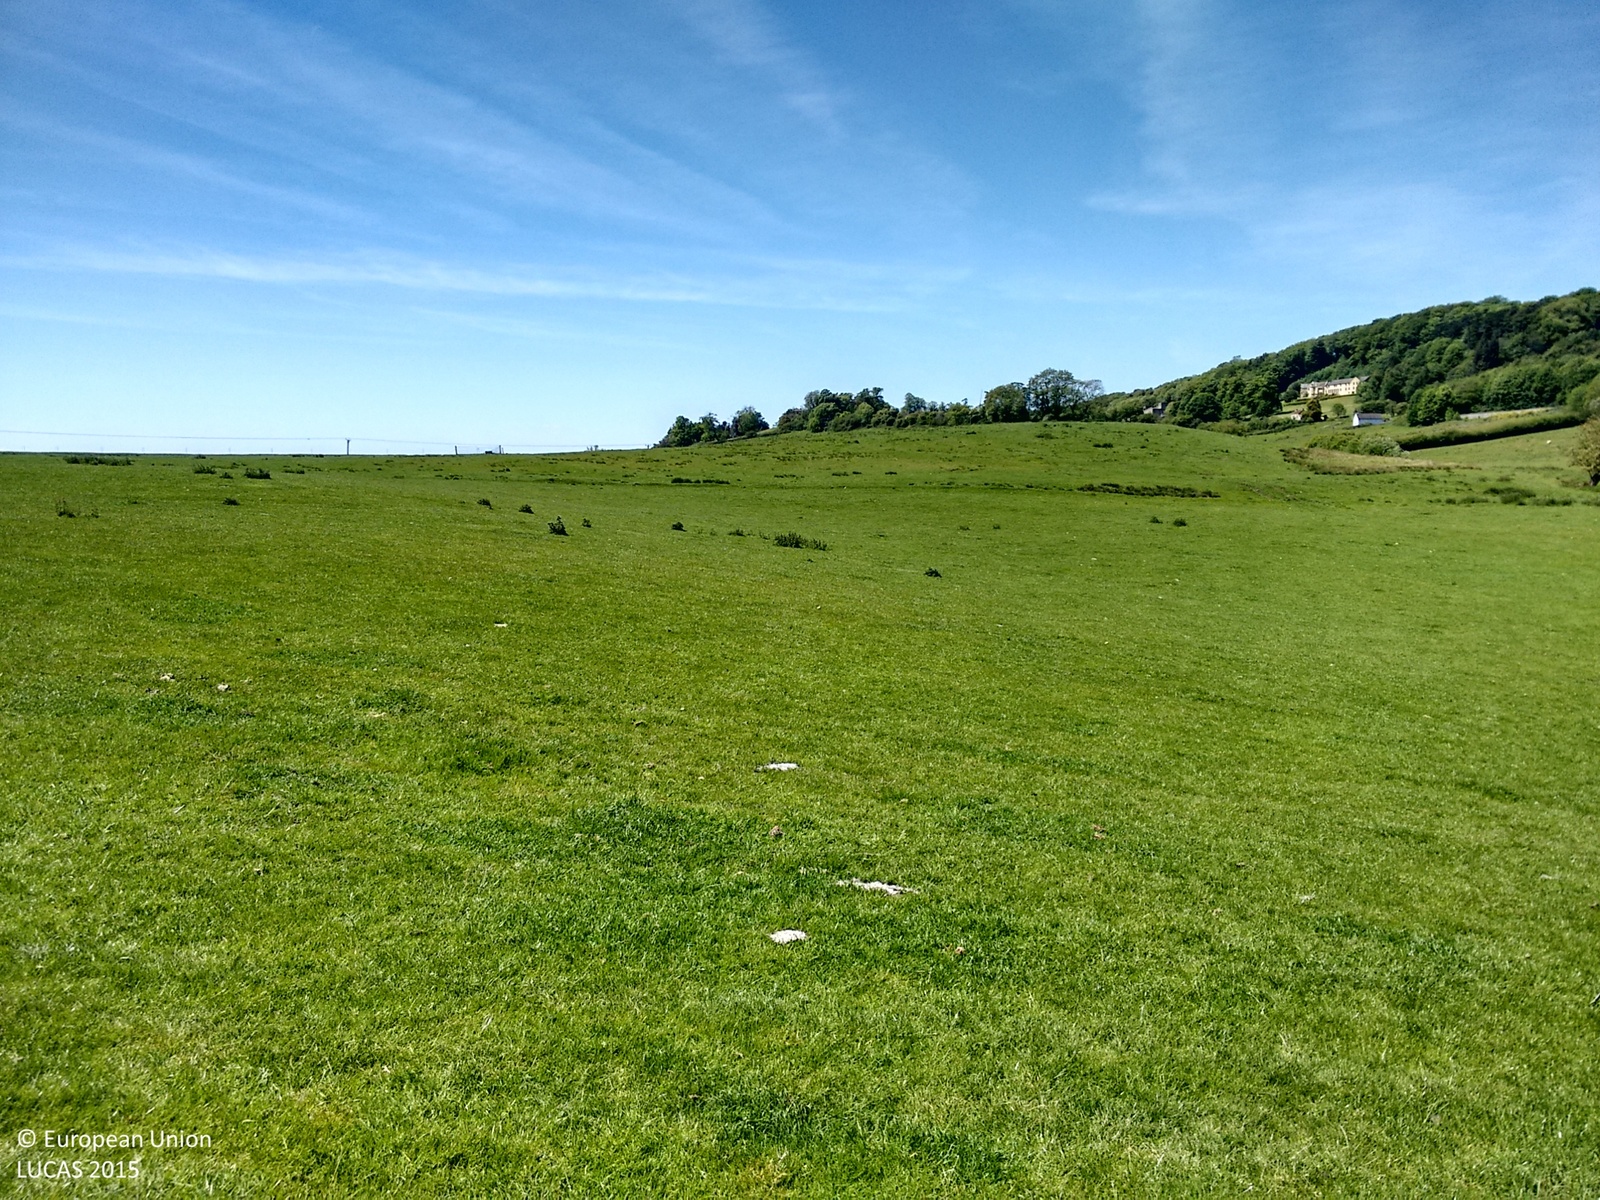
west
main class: Grassland
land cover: Grassland without tree/shrub cover
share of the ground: > 75 %
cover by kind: herbaceous plants 100 %
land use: Agriculture (excluding fallow land and kitchen gardens)
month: June
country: GB
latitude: 54.2003
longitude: -1.0650
